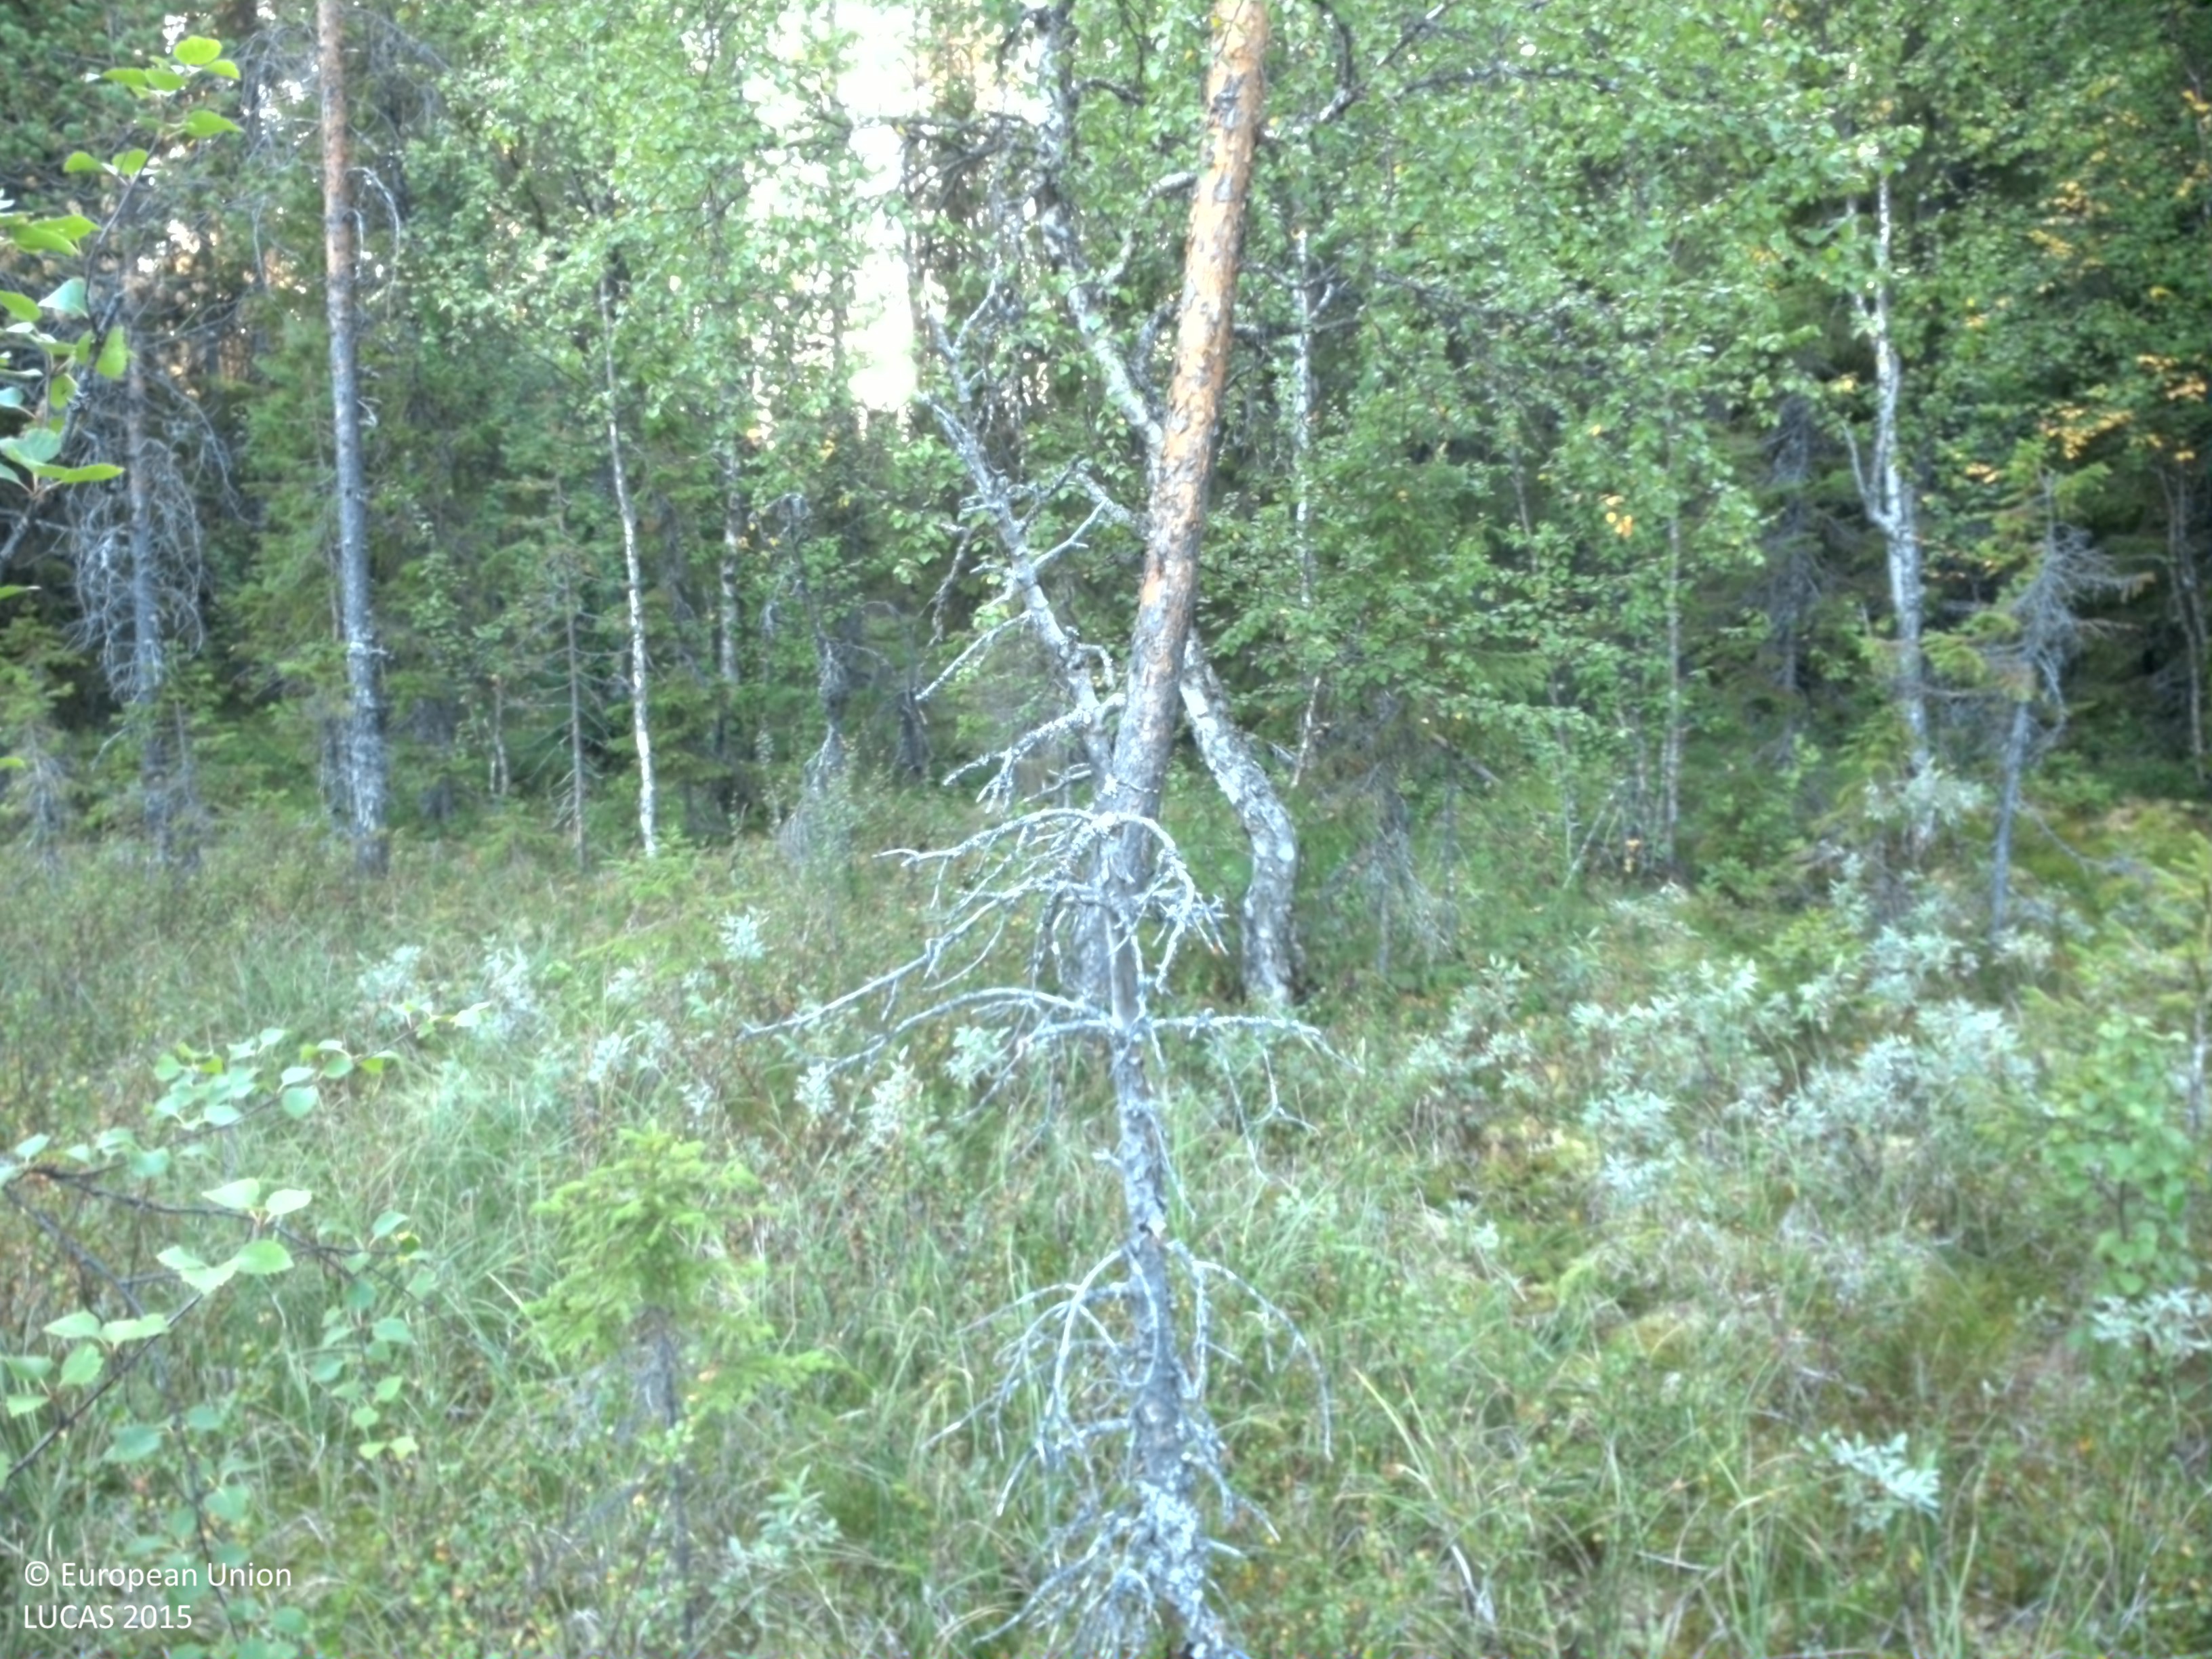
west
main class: Shrubland
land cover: Shrubland with sparse tree cover
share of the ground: 25 - 50 %
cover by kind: herbaceous plants 35 %, lichens and mosses 35 %, shrubs 25 %, coniferous forest trees 5 %
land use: Semi-natural and natural areas not in use
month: August
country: SE
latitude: 64.7065
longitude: 16.7836
